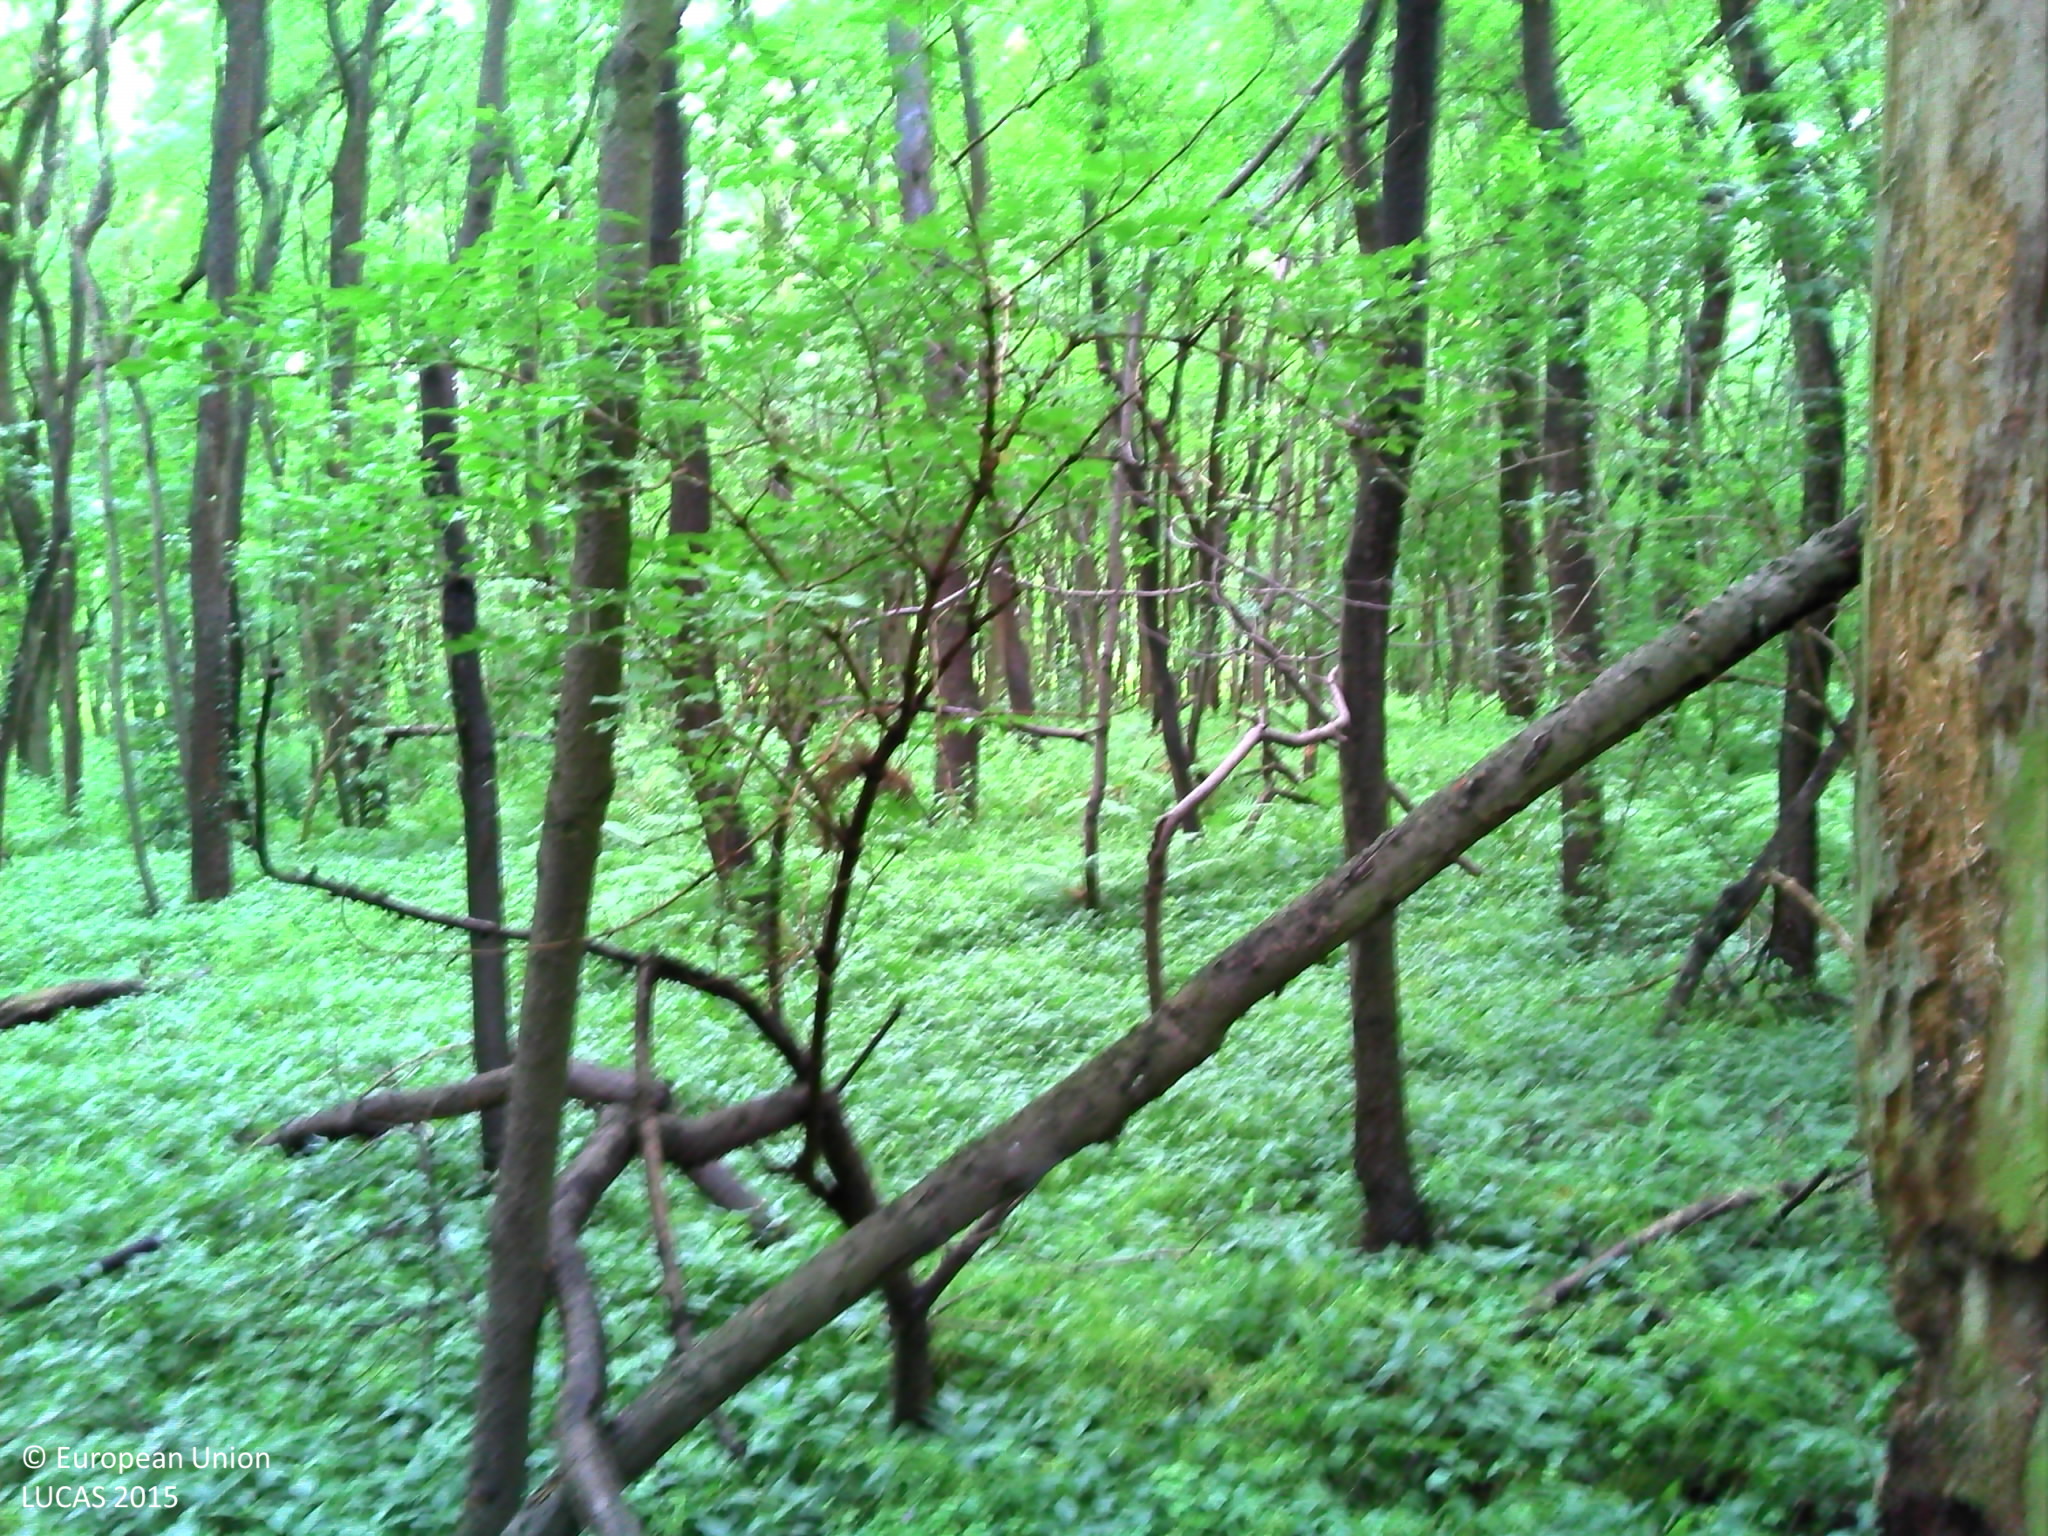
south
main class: Woodland
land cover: Broadleaved woodland
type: mesophytic deciduous forest
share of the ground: > 75 %
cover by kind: broadleaved forest trees 75 %, herbaceous plants 20 %, shrubs 5 %
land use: Forestry
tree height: > 5 m
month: June
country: BE
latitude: 50.4952
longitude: 4.0031
